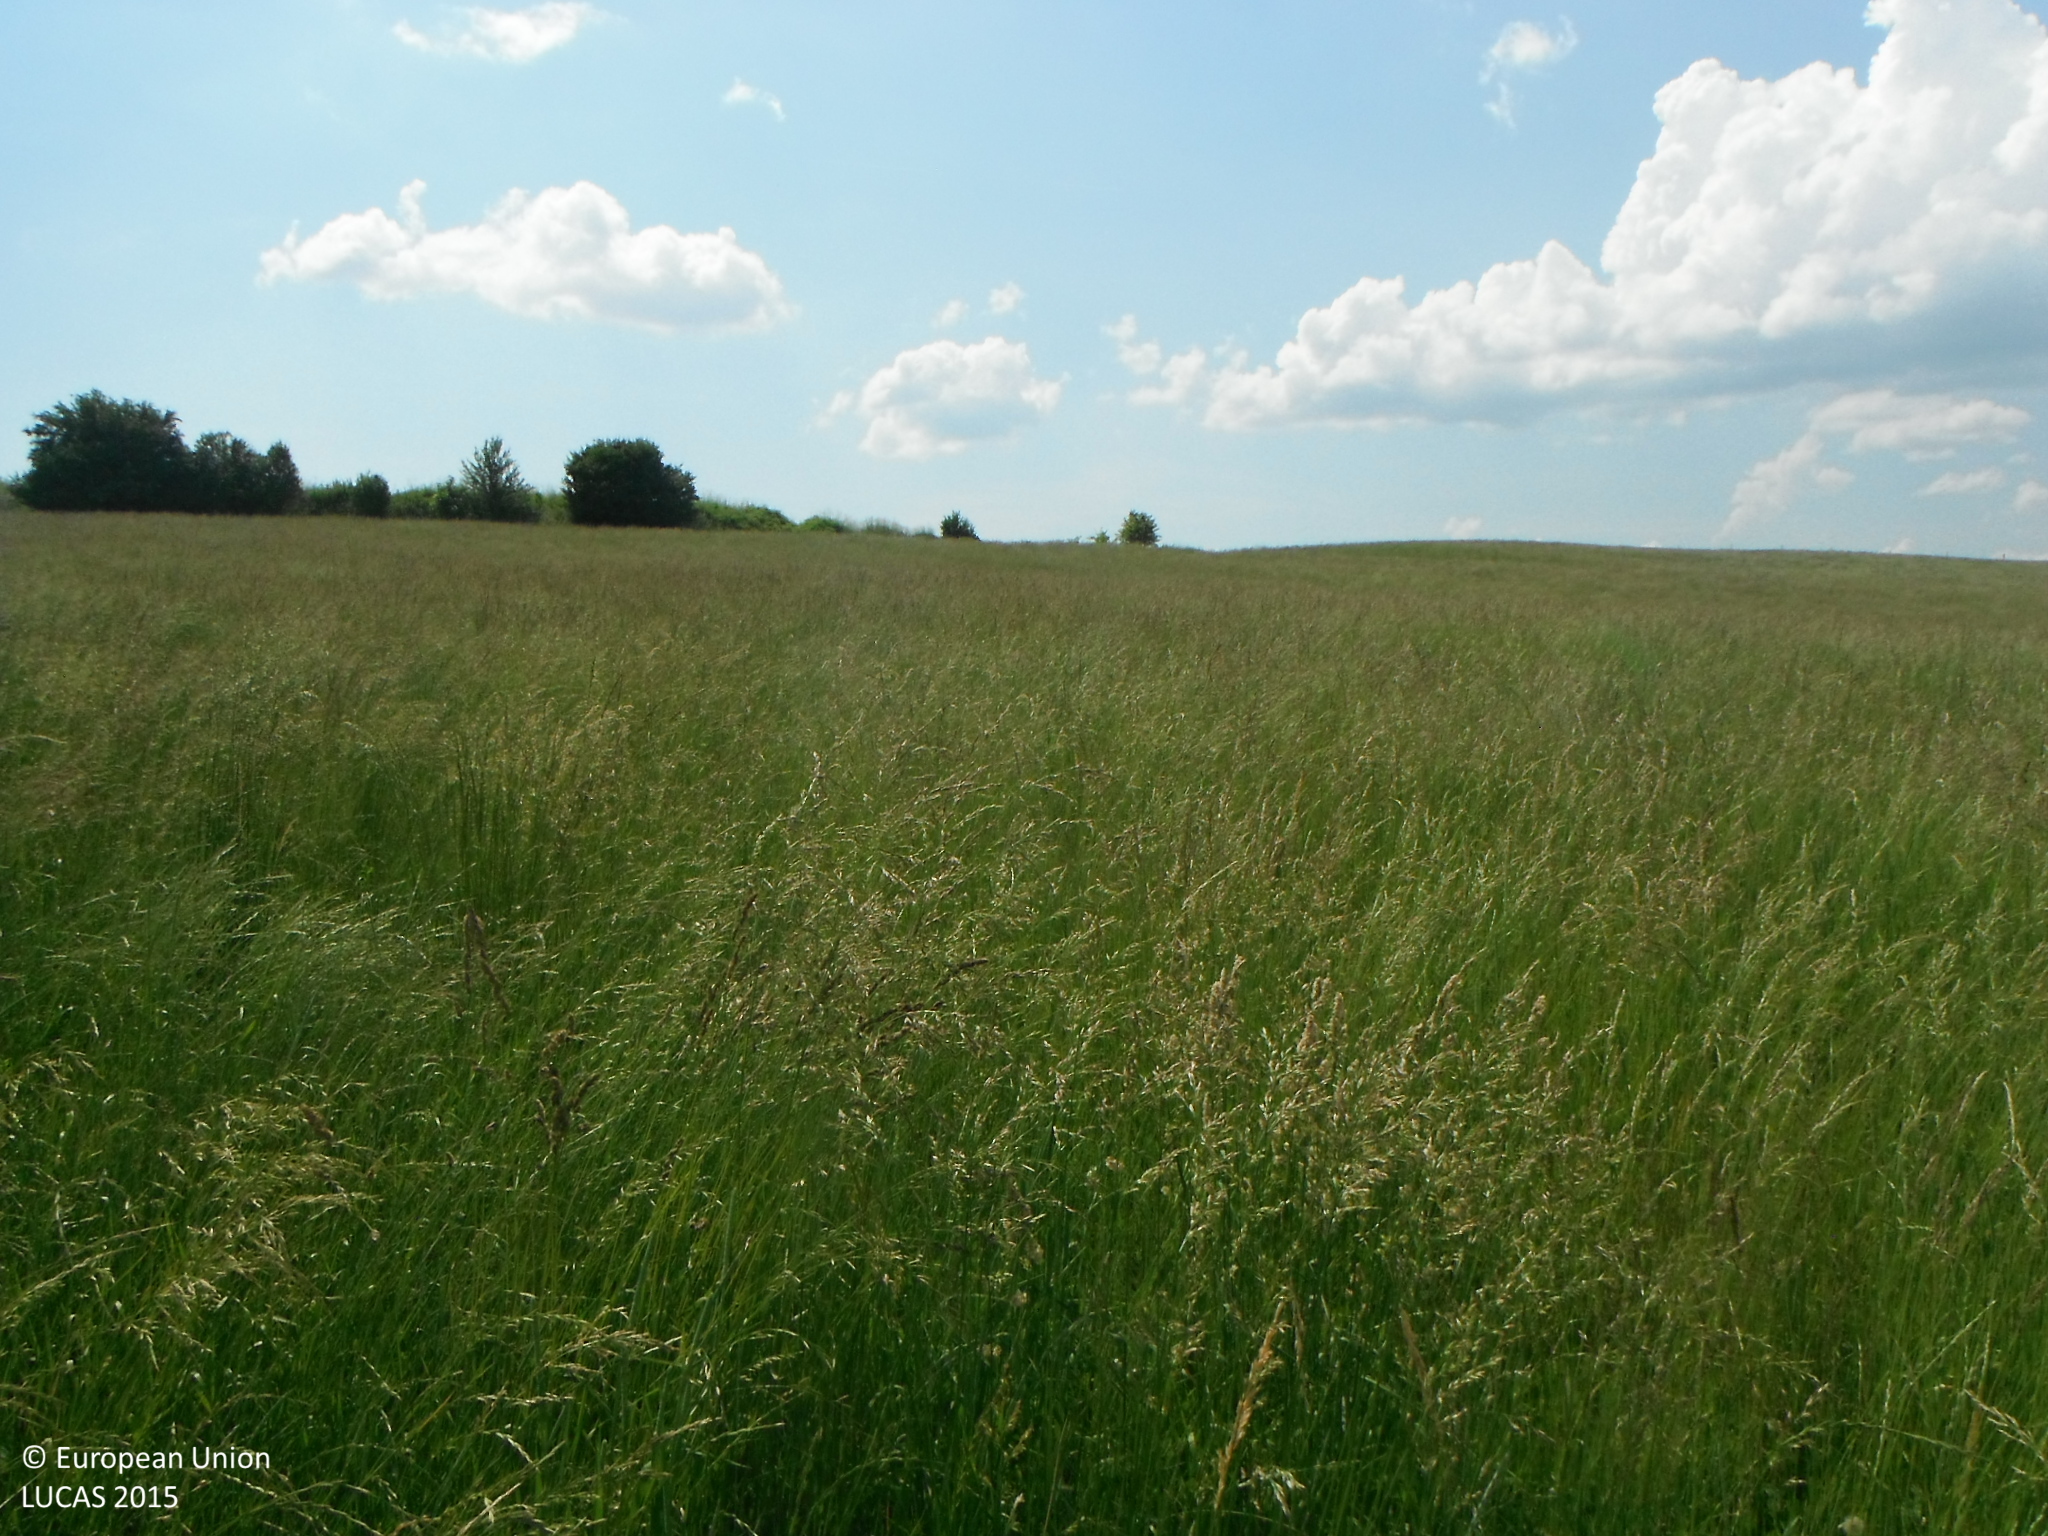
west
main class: Grassland
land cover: Grassland without tree/shrub cover
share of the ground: > 75 %
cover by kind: herbaceous plants 100 %
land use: Agriculture (excluding fallow land and kitchen gardens)
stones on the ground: < 10 %
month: June
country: SK
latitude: 48.6675
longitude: 19.2428
